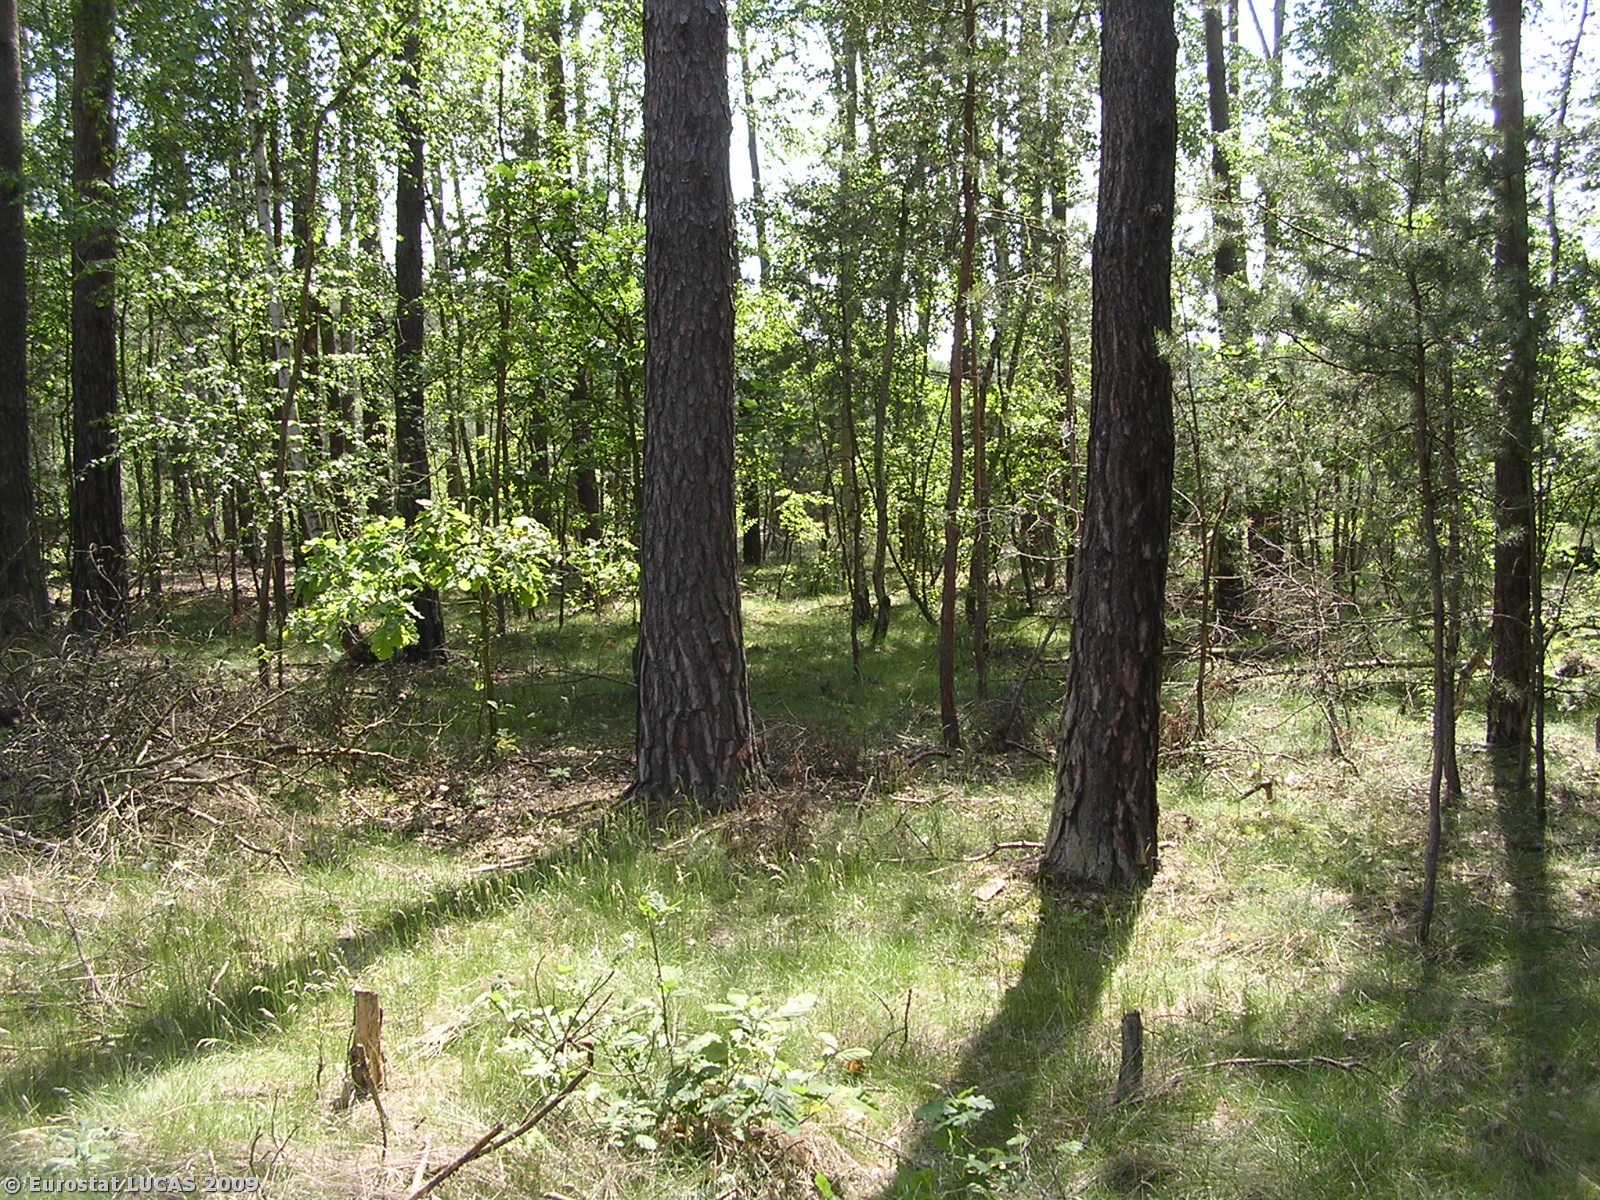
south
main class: Grassland
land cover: Grassland with sparse tree/shrub cover
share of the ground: > 75 %
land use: Forestry
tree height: > 5 m
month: May
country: CZ
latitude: 50.2315
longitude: 14.6984
